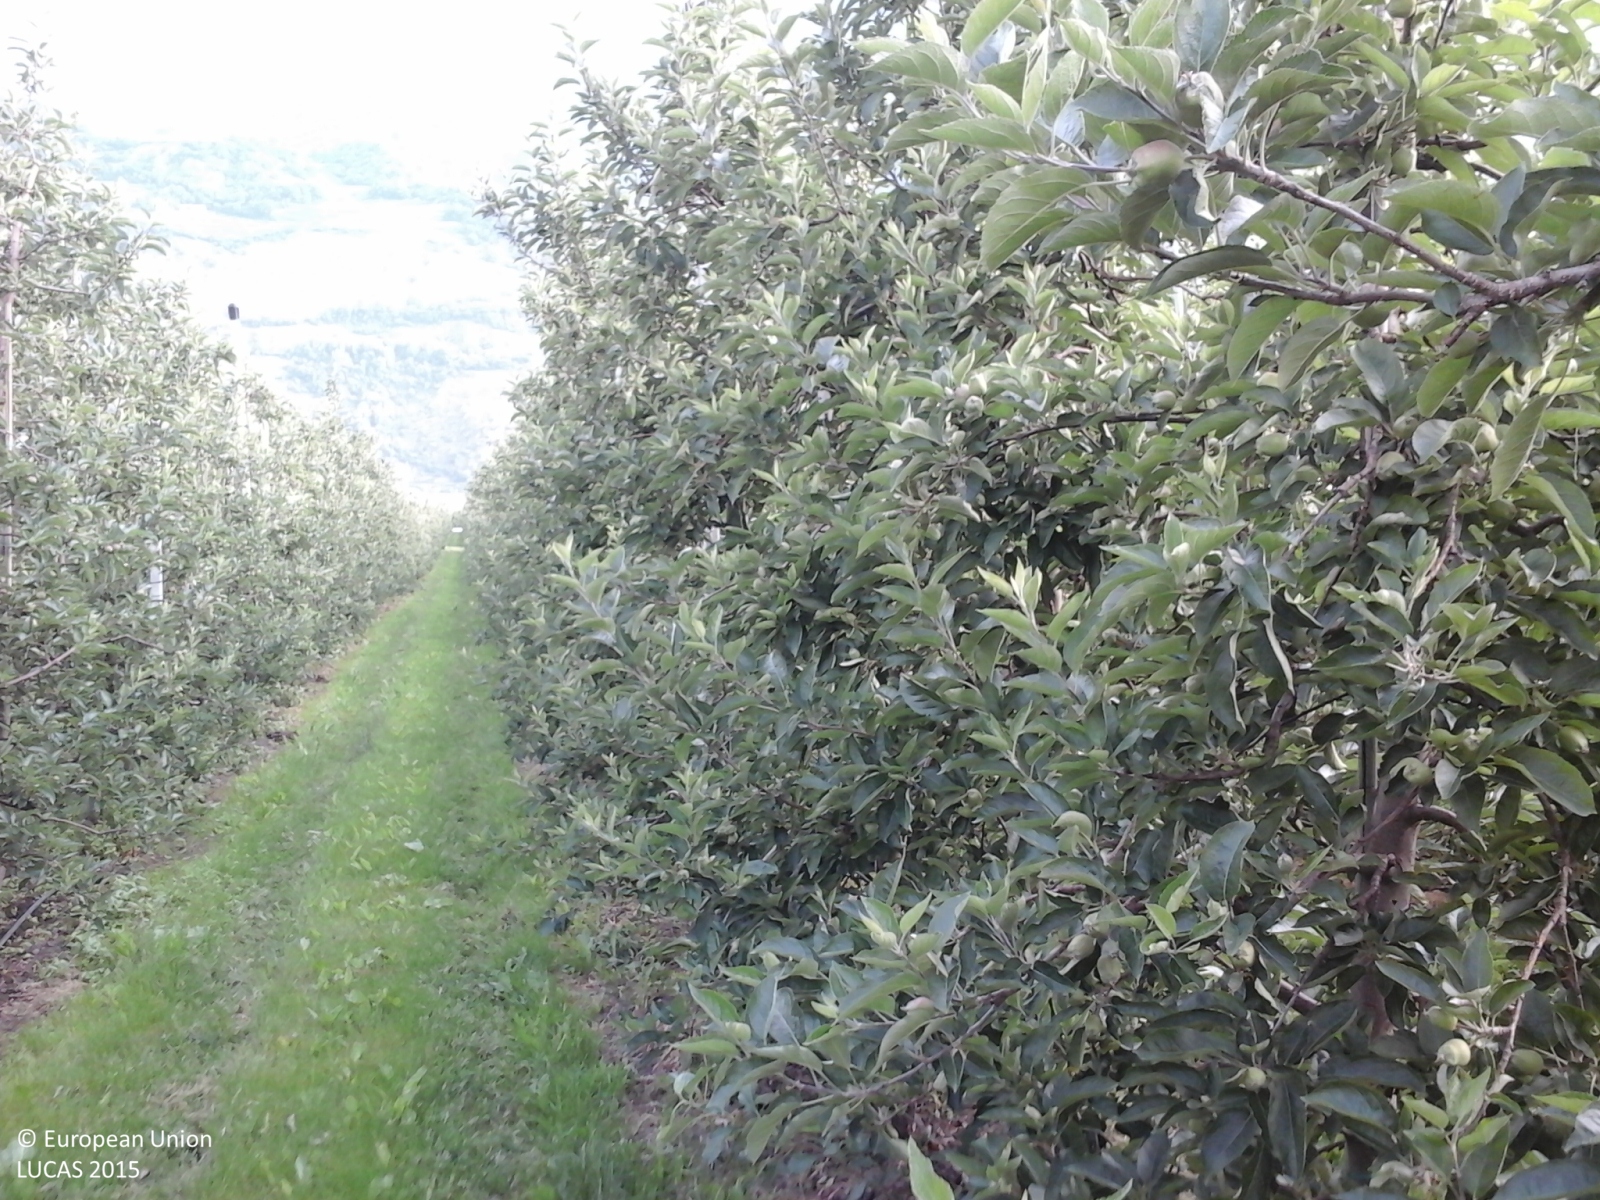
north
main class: Cropland
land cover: Apple fruit
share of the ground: > 75 %
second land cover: Grassland without tree/shrub cover
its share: > 75 %
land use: Agriculture (excluding fallow land and kitchen gardens)
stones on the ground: < 10 %
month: June
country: IT
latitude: 46.6349
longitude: 10.9785
